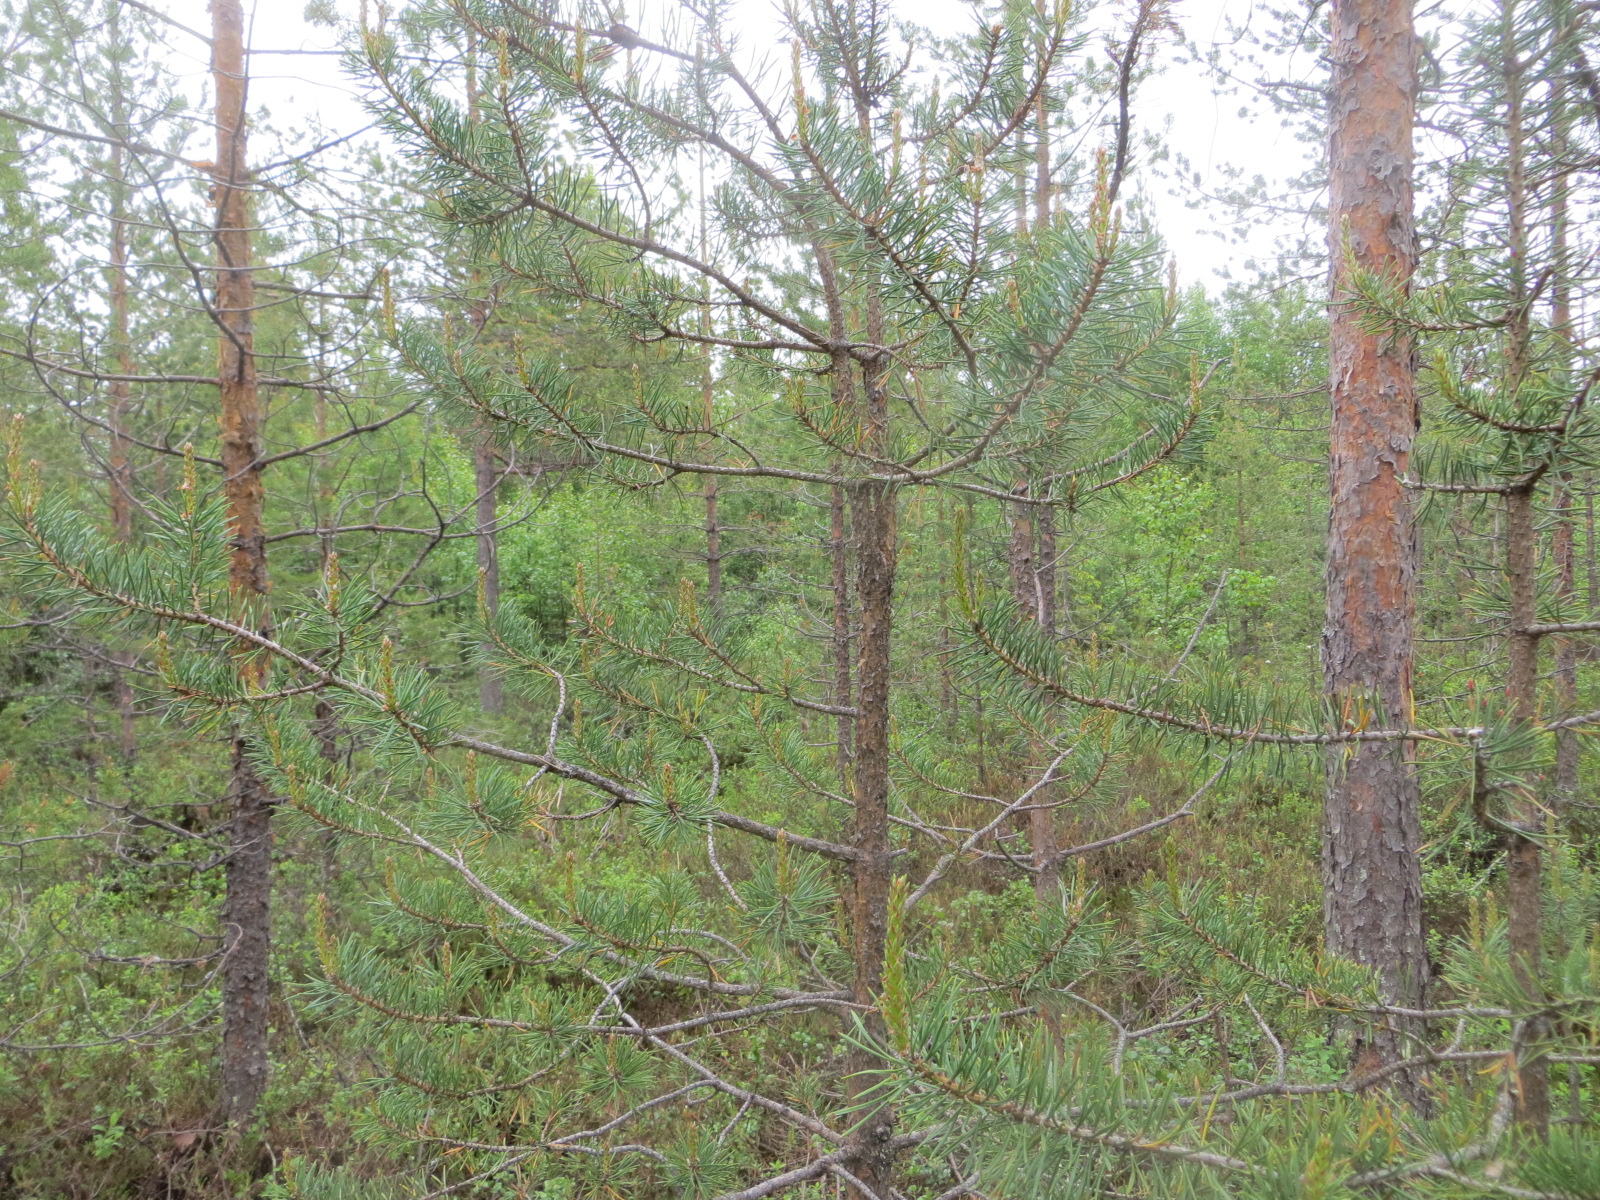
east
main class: Woodland
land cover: Pine dominated coniferous woodland
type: boreal forest
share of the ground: > 75 %
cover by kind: coniferous forest trees 75 %, shrubs 25 %
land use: Forestry
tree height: > 5 m
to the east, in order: Pine dominated coniferous woodland; Ditches and canals; Pine dominated mixed woodland; Ditches and canals; Pine dominated mixed woodland; Ditches and canals; Pine dominated mixed woodland; Ditches and canals; Pine dominated mixed woodland; Ditches and canals; Pine dominated mixed woodland; Pine dominated coniferous woodland; Ditches and canals; Pine dominated coniferous woodland; Ditches and canals; Pine dominated coniferous woodland
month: June
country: FI
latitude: 66.5906
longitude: 24.6855
